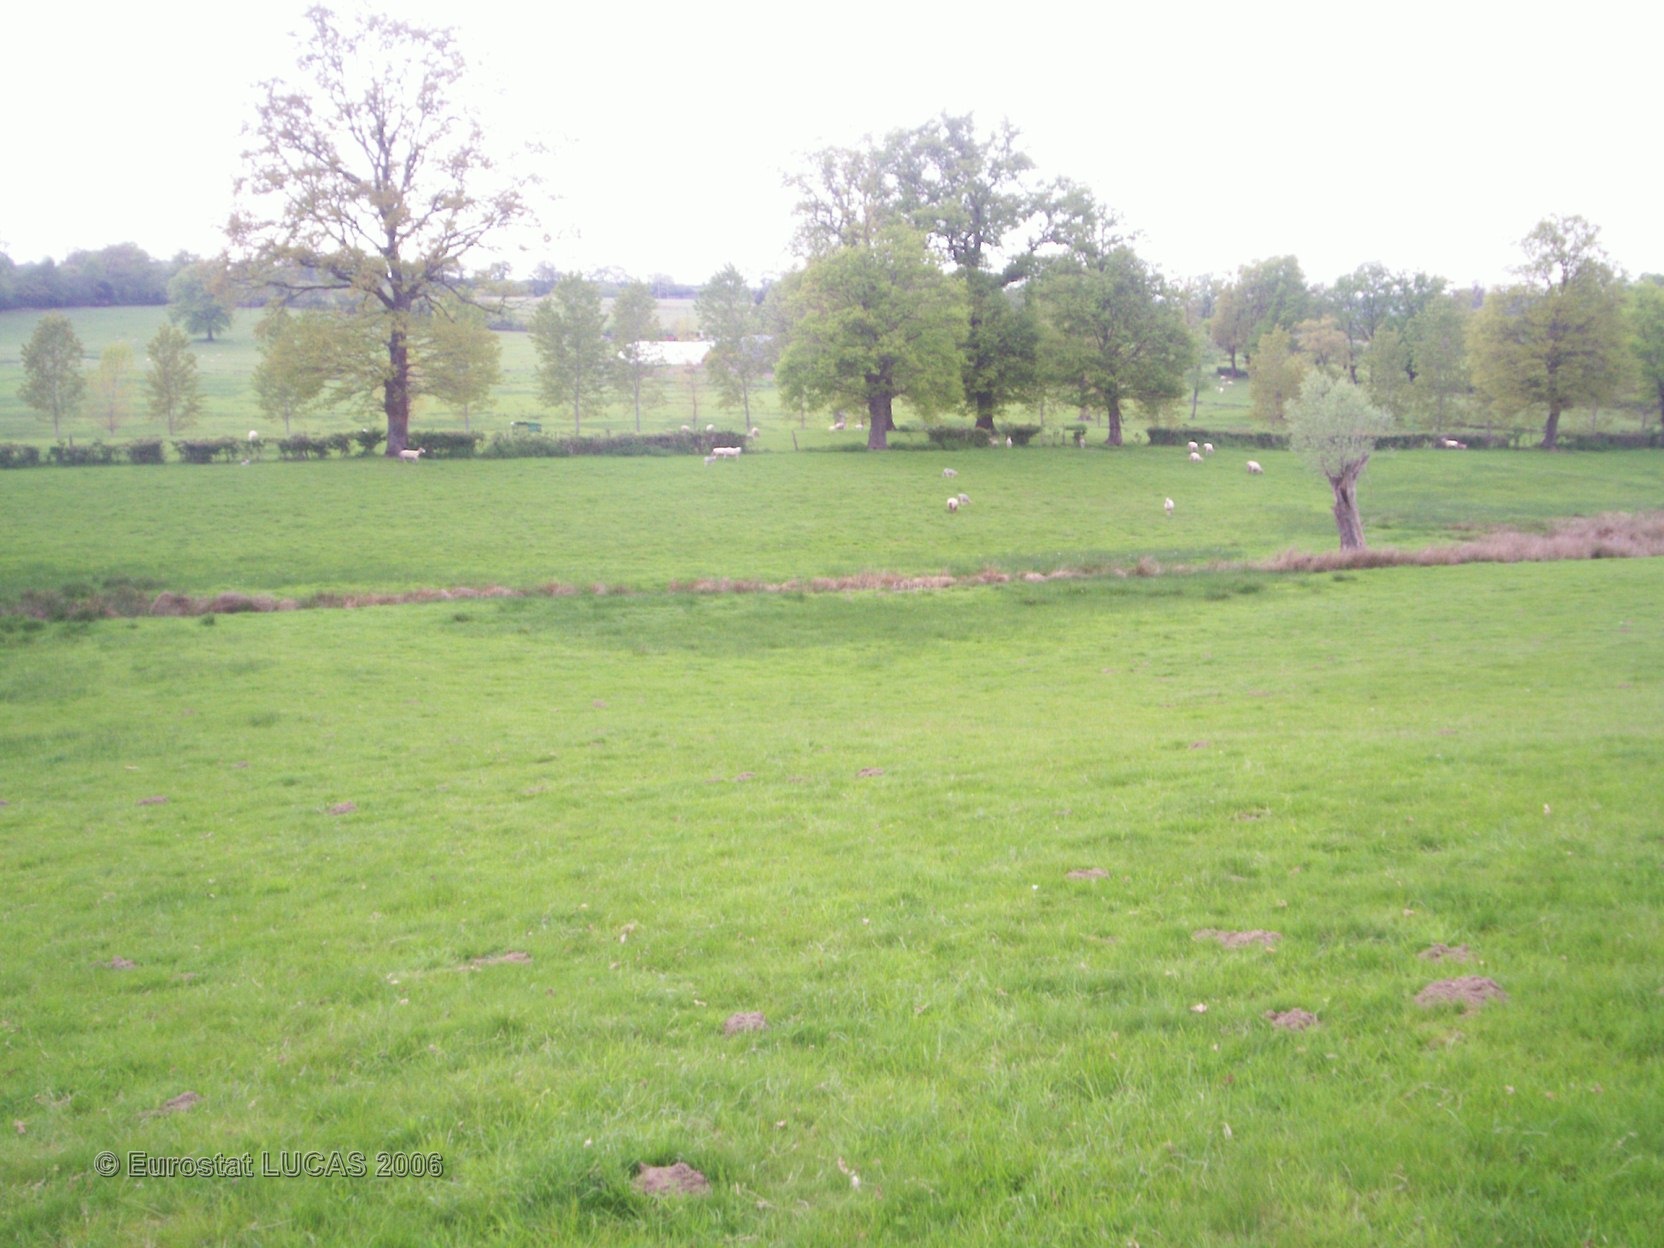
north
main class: Grassland
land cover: Grassland without tree/shrub cover
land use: Agriculture (excluding fallow land and kitchen gardens)
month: May
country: FR
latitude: 46.4722
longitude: 3.1081
